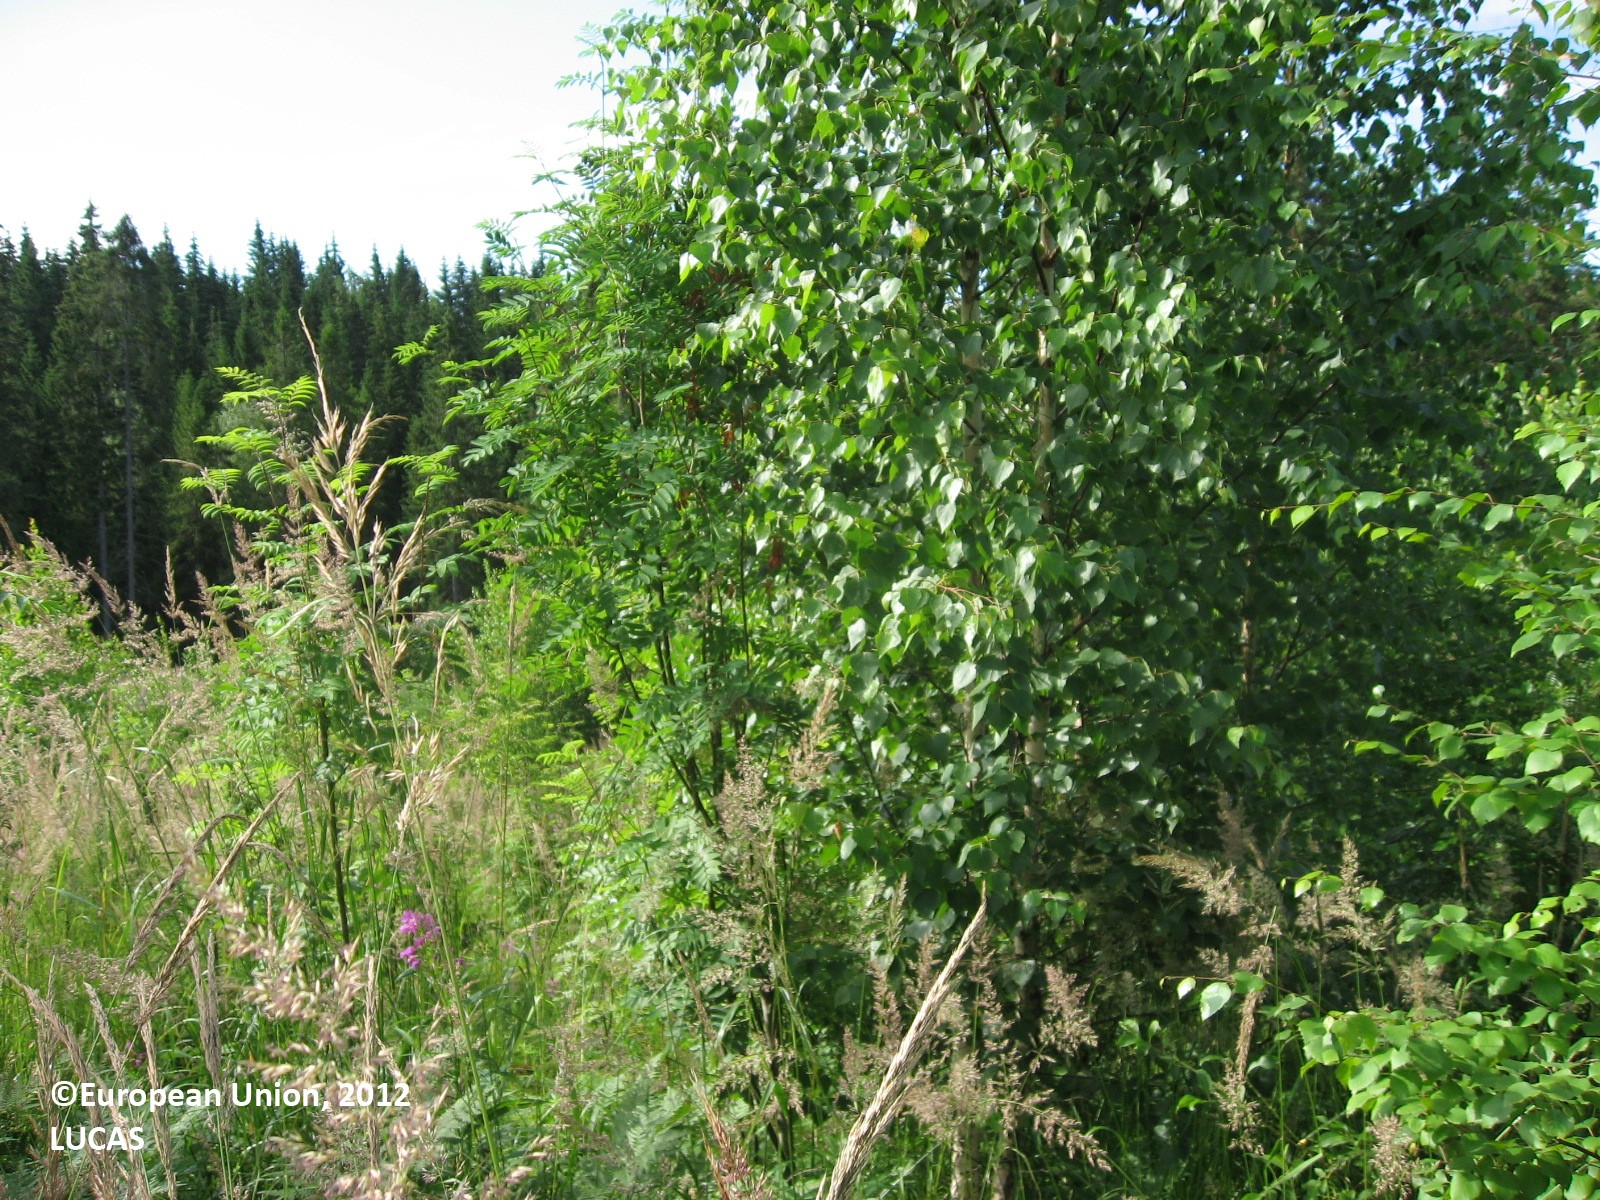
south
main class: Woodland
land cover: Broadleaved woodland
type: boreal forest
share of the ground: 10 - 25 %
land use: Forestry
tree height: < 5 m
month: July
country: FI
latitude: 61.2002
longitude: 25.7801
